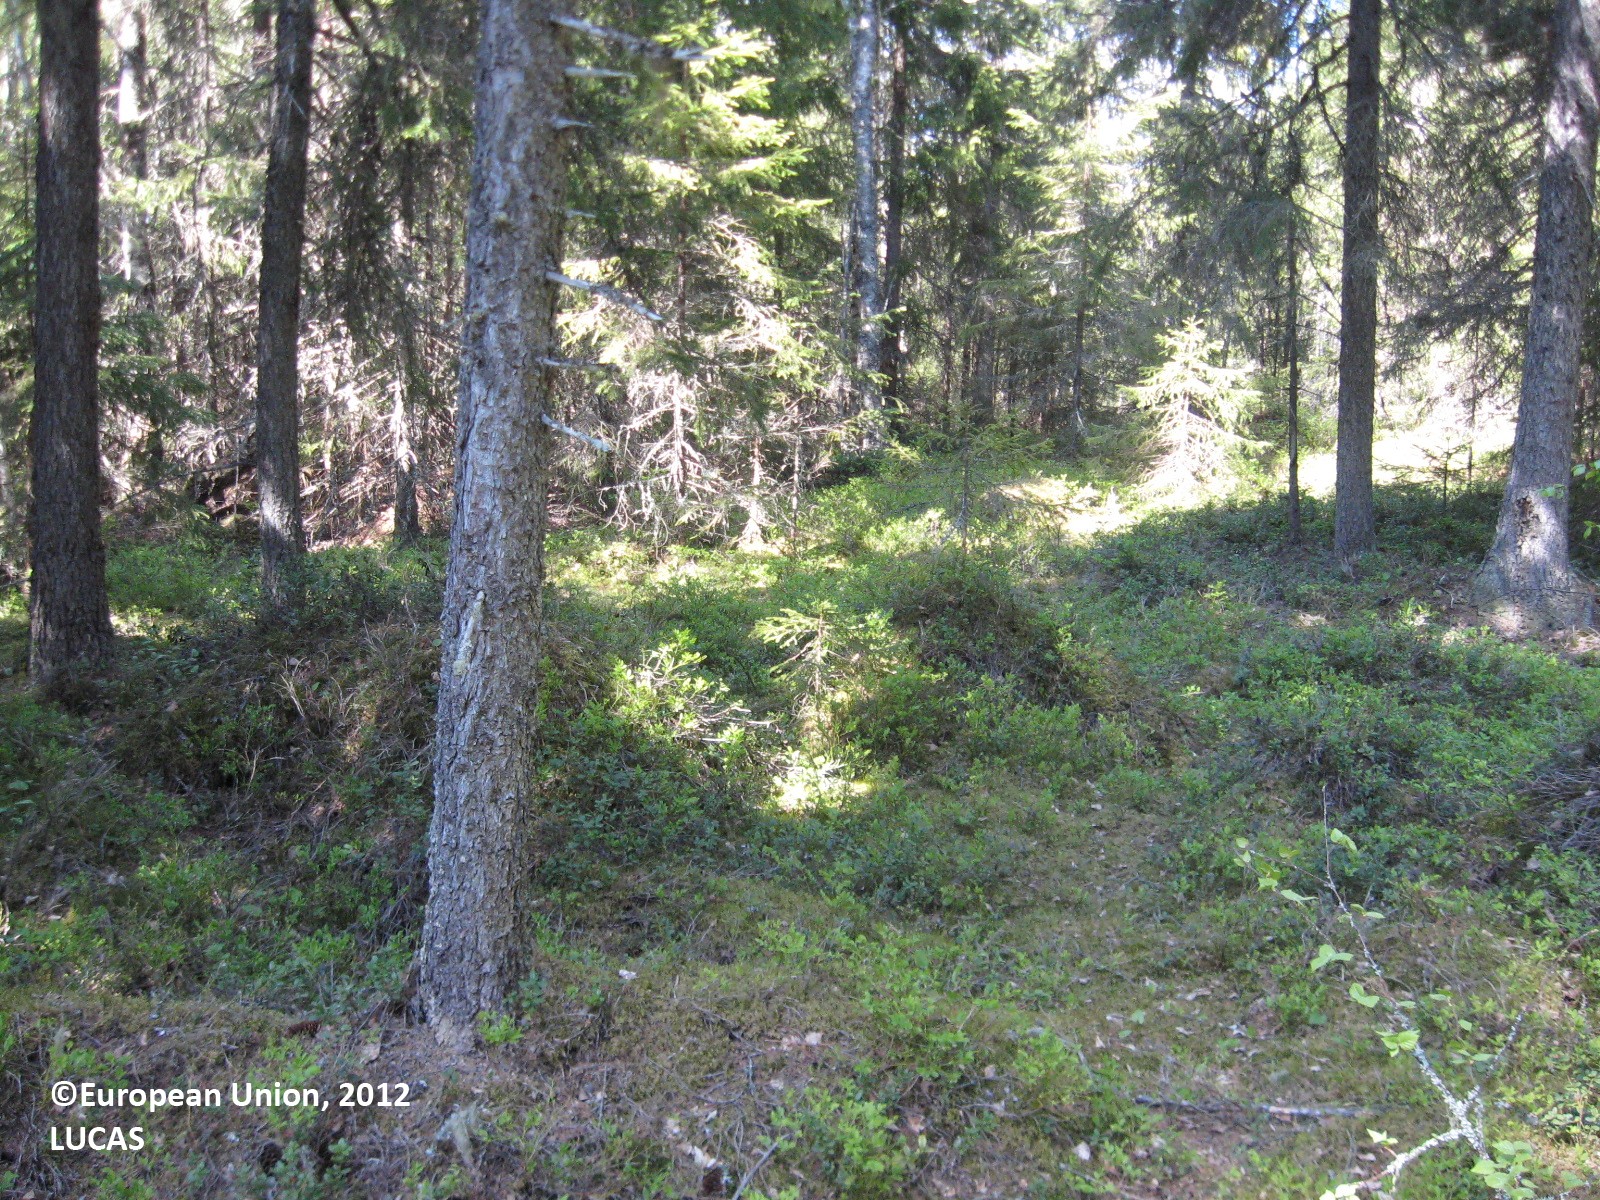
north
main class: Woodland
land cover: Spruce dominated coniferous woodland
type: boreal forest
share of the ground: > 75 %
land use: Forestry
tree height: > 5 m
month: June
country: FI
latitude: 63.2546
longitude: 21.4093
